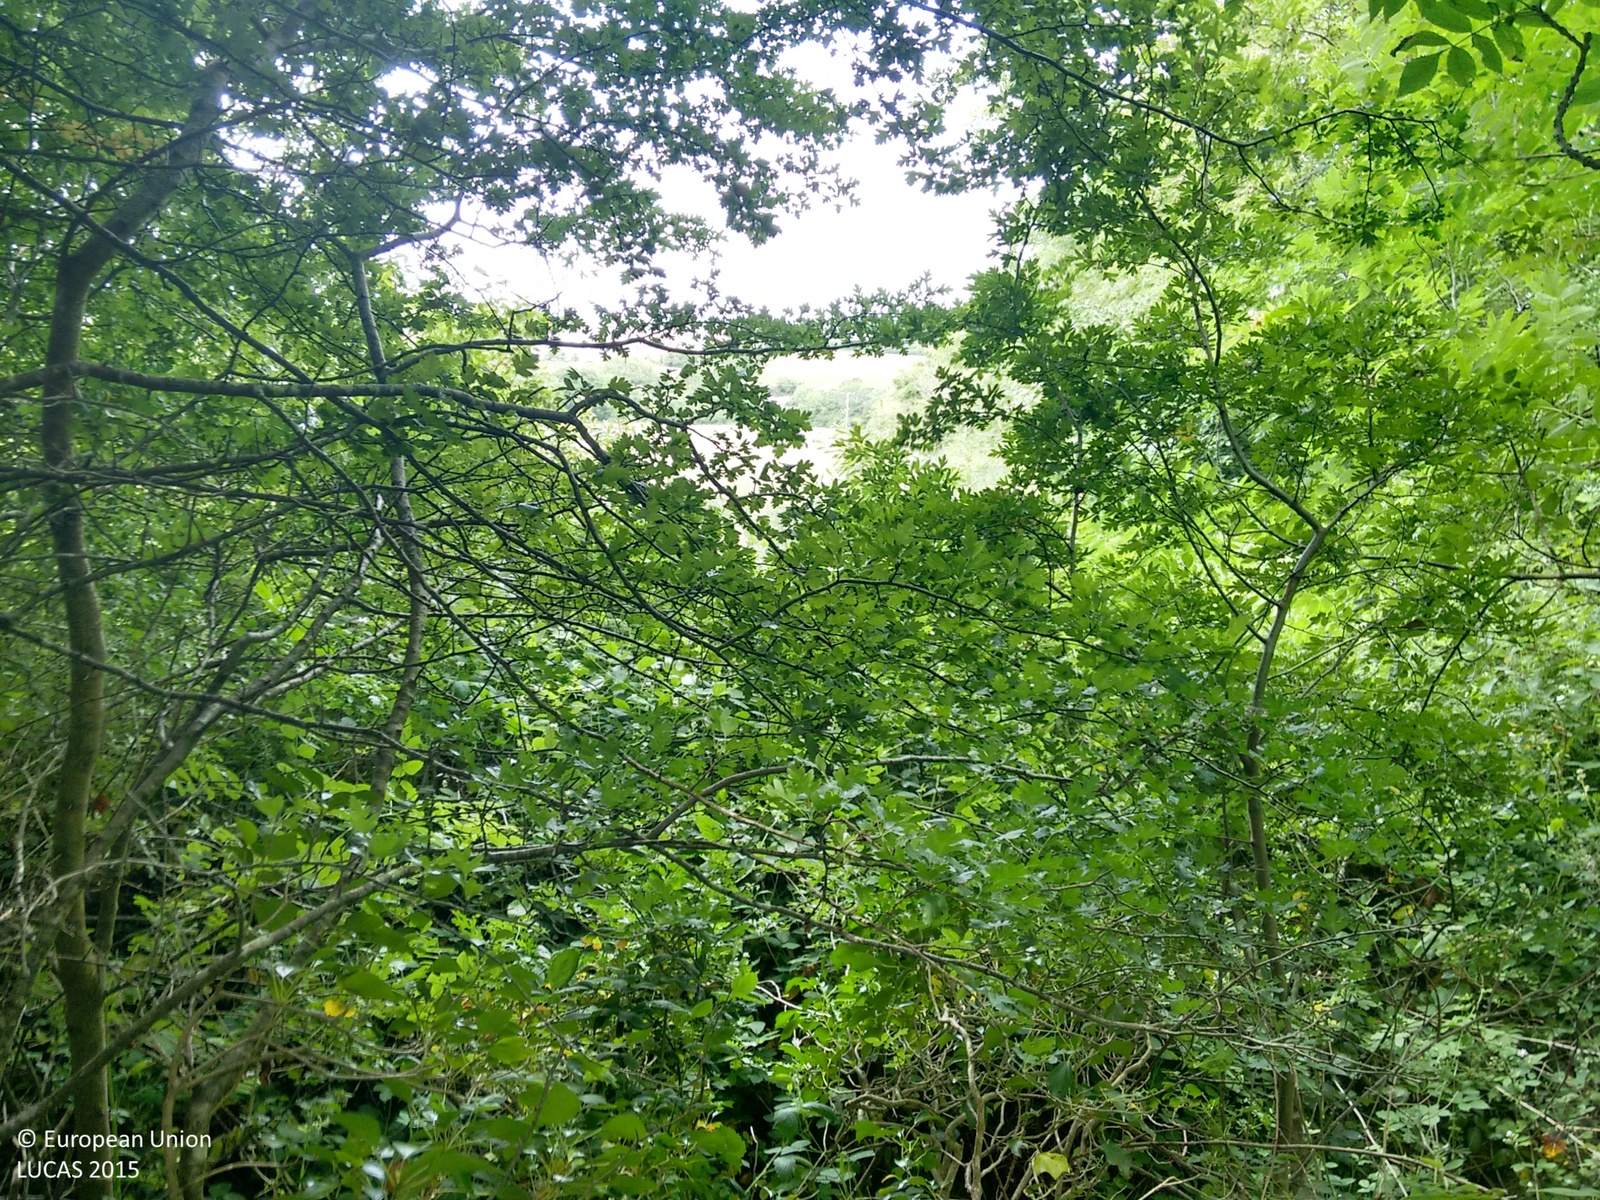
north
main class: Cropland
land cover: Oats
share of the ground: > 75 %
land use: Agriculture (excluding fallow land and kitchen gardens)
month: July
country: IE
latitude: 52.1685
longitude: -8.9097
